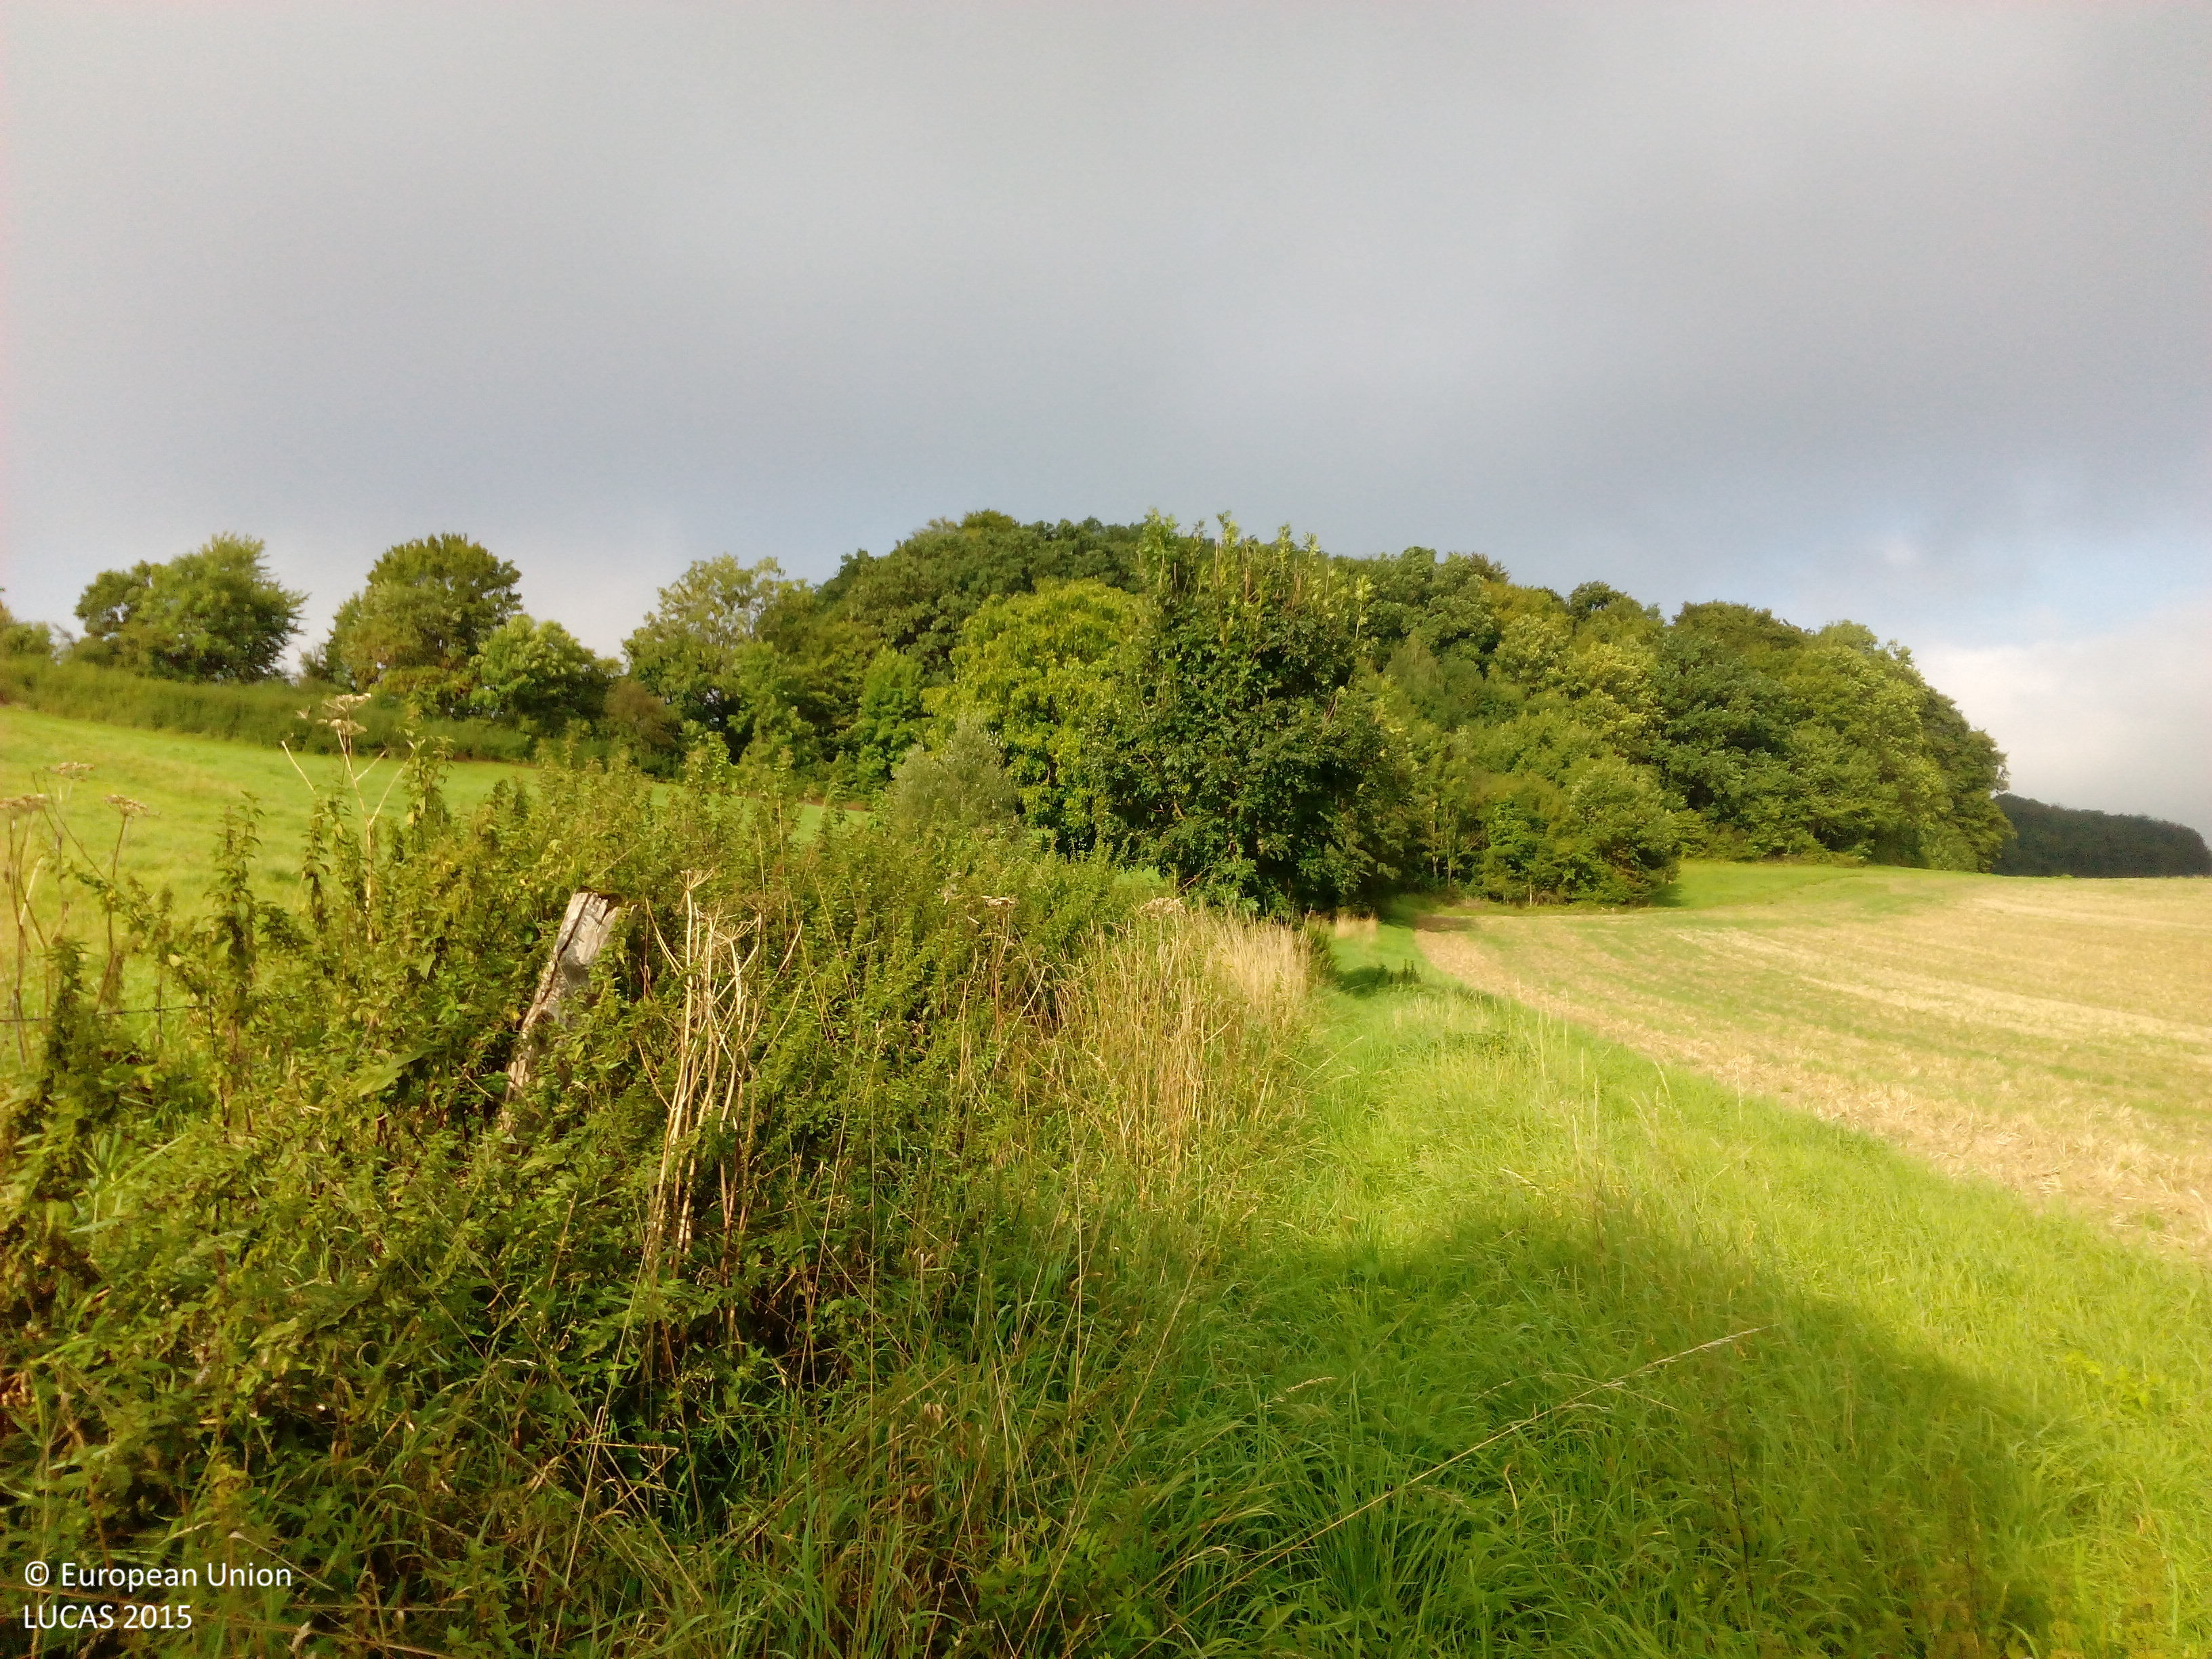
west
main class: Grassland
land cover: Grassland with sparse tree/shrub cover
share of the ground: > 75 %
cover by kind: herbaceous plants 90 %, broadleaved forest trees 5 %, shrubs 5 %
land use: Agriculture (excluding fallow land and kitchen gardens)
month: September
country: DE
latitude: 51.4068
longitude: 9.9569
